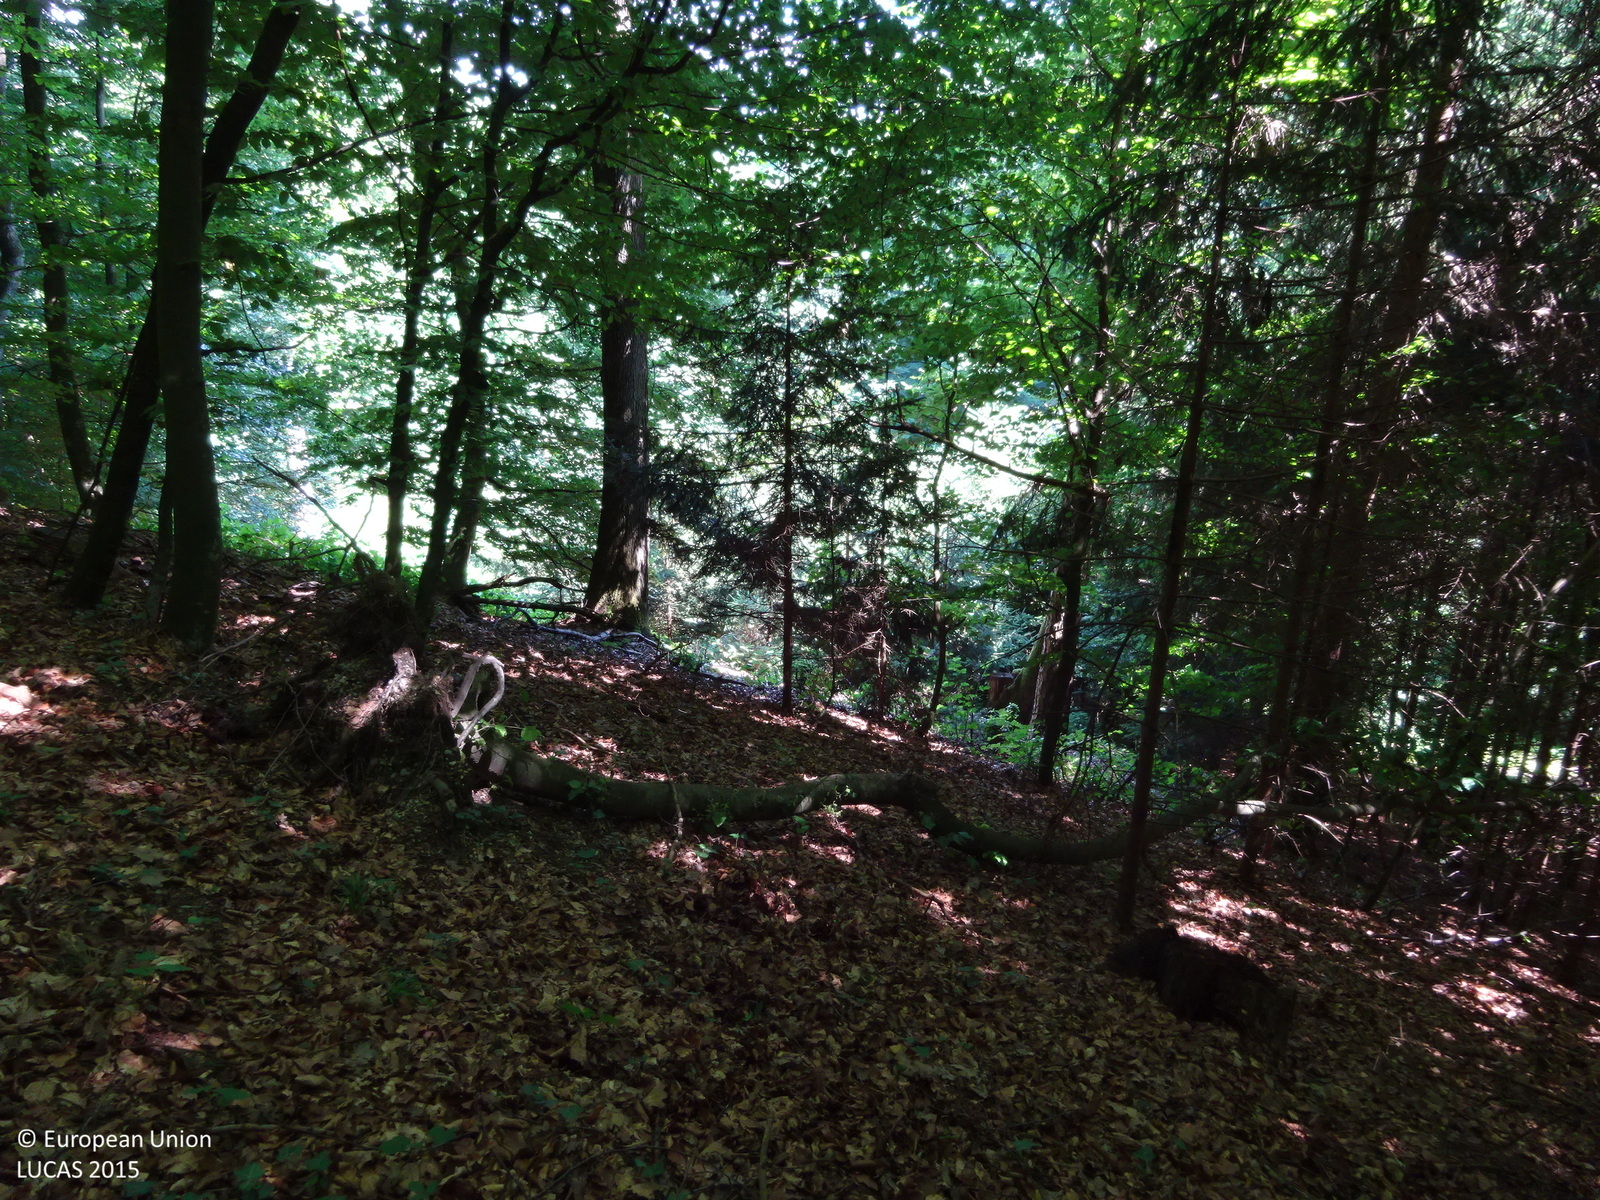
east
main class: Woodland
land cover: Spruce dominated mixed woodland
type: mountainous beech forest
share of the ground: > 75 %
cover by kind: broadleaved forest trees 75 %, coniferous forest trees 25 %
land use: Forestry
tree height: > 5 m
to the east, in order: Spruce dominated mixed woodland; Spruce dominated coniferous woodland; Tracks; Broadleaved woodland; Grass margins; Ditches and canals; Paved roads, cycling and walking lanes; Grass margins; Maize; Grassland without tree/shrub cover; Broadleaved woodland
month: June
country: AT
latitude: 46.7852
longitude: 15.8816
